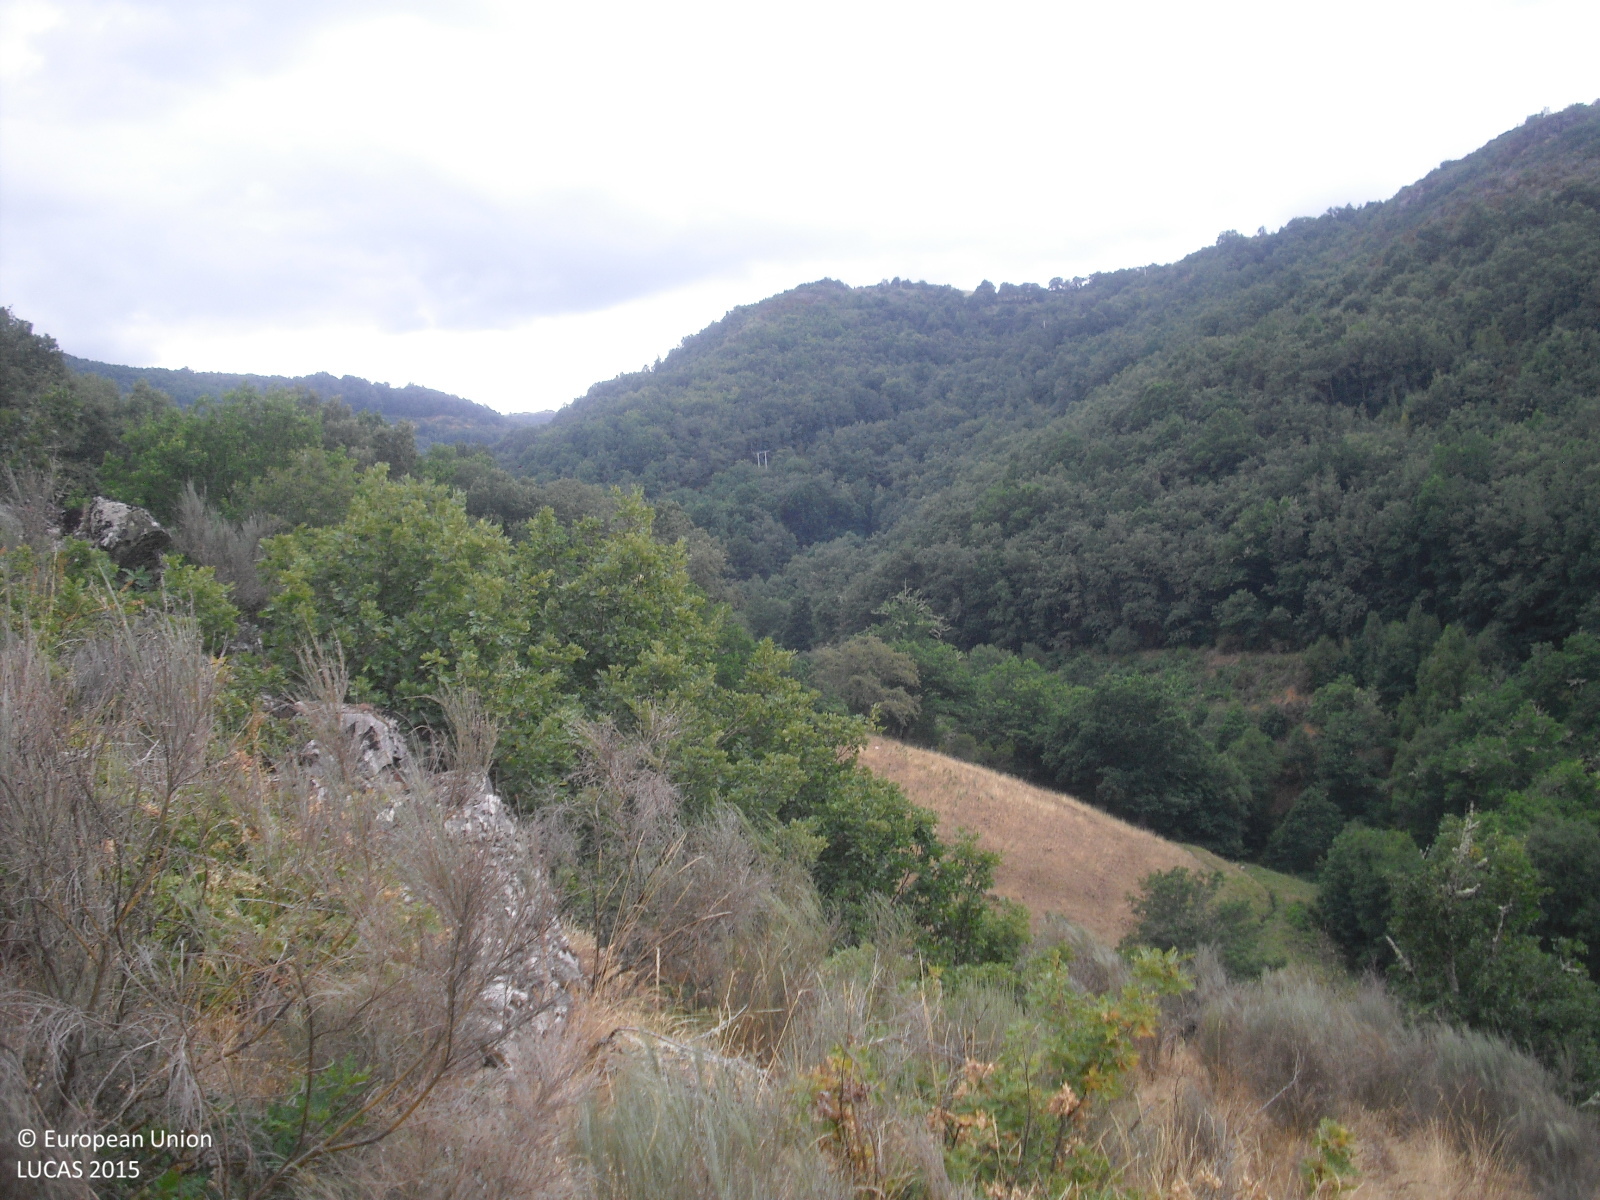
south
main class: Shrubland
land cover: Shrubland without tree cover
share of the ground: > 75 %
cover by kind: shrubs 100 %
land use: Semi-natural and natural areas not in use
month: July
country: ES
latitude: 42.2827
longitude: -7.3674
